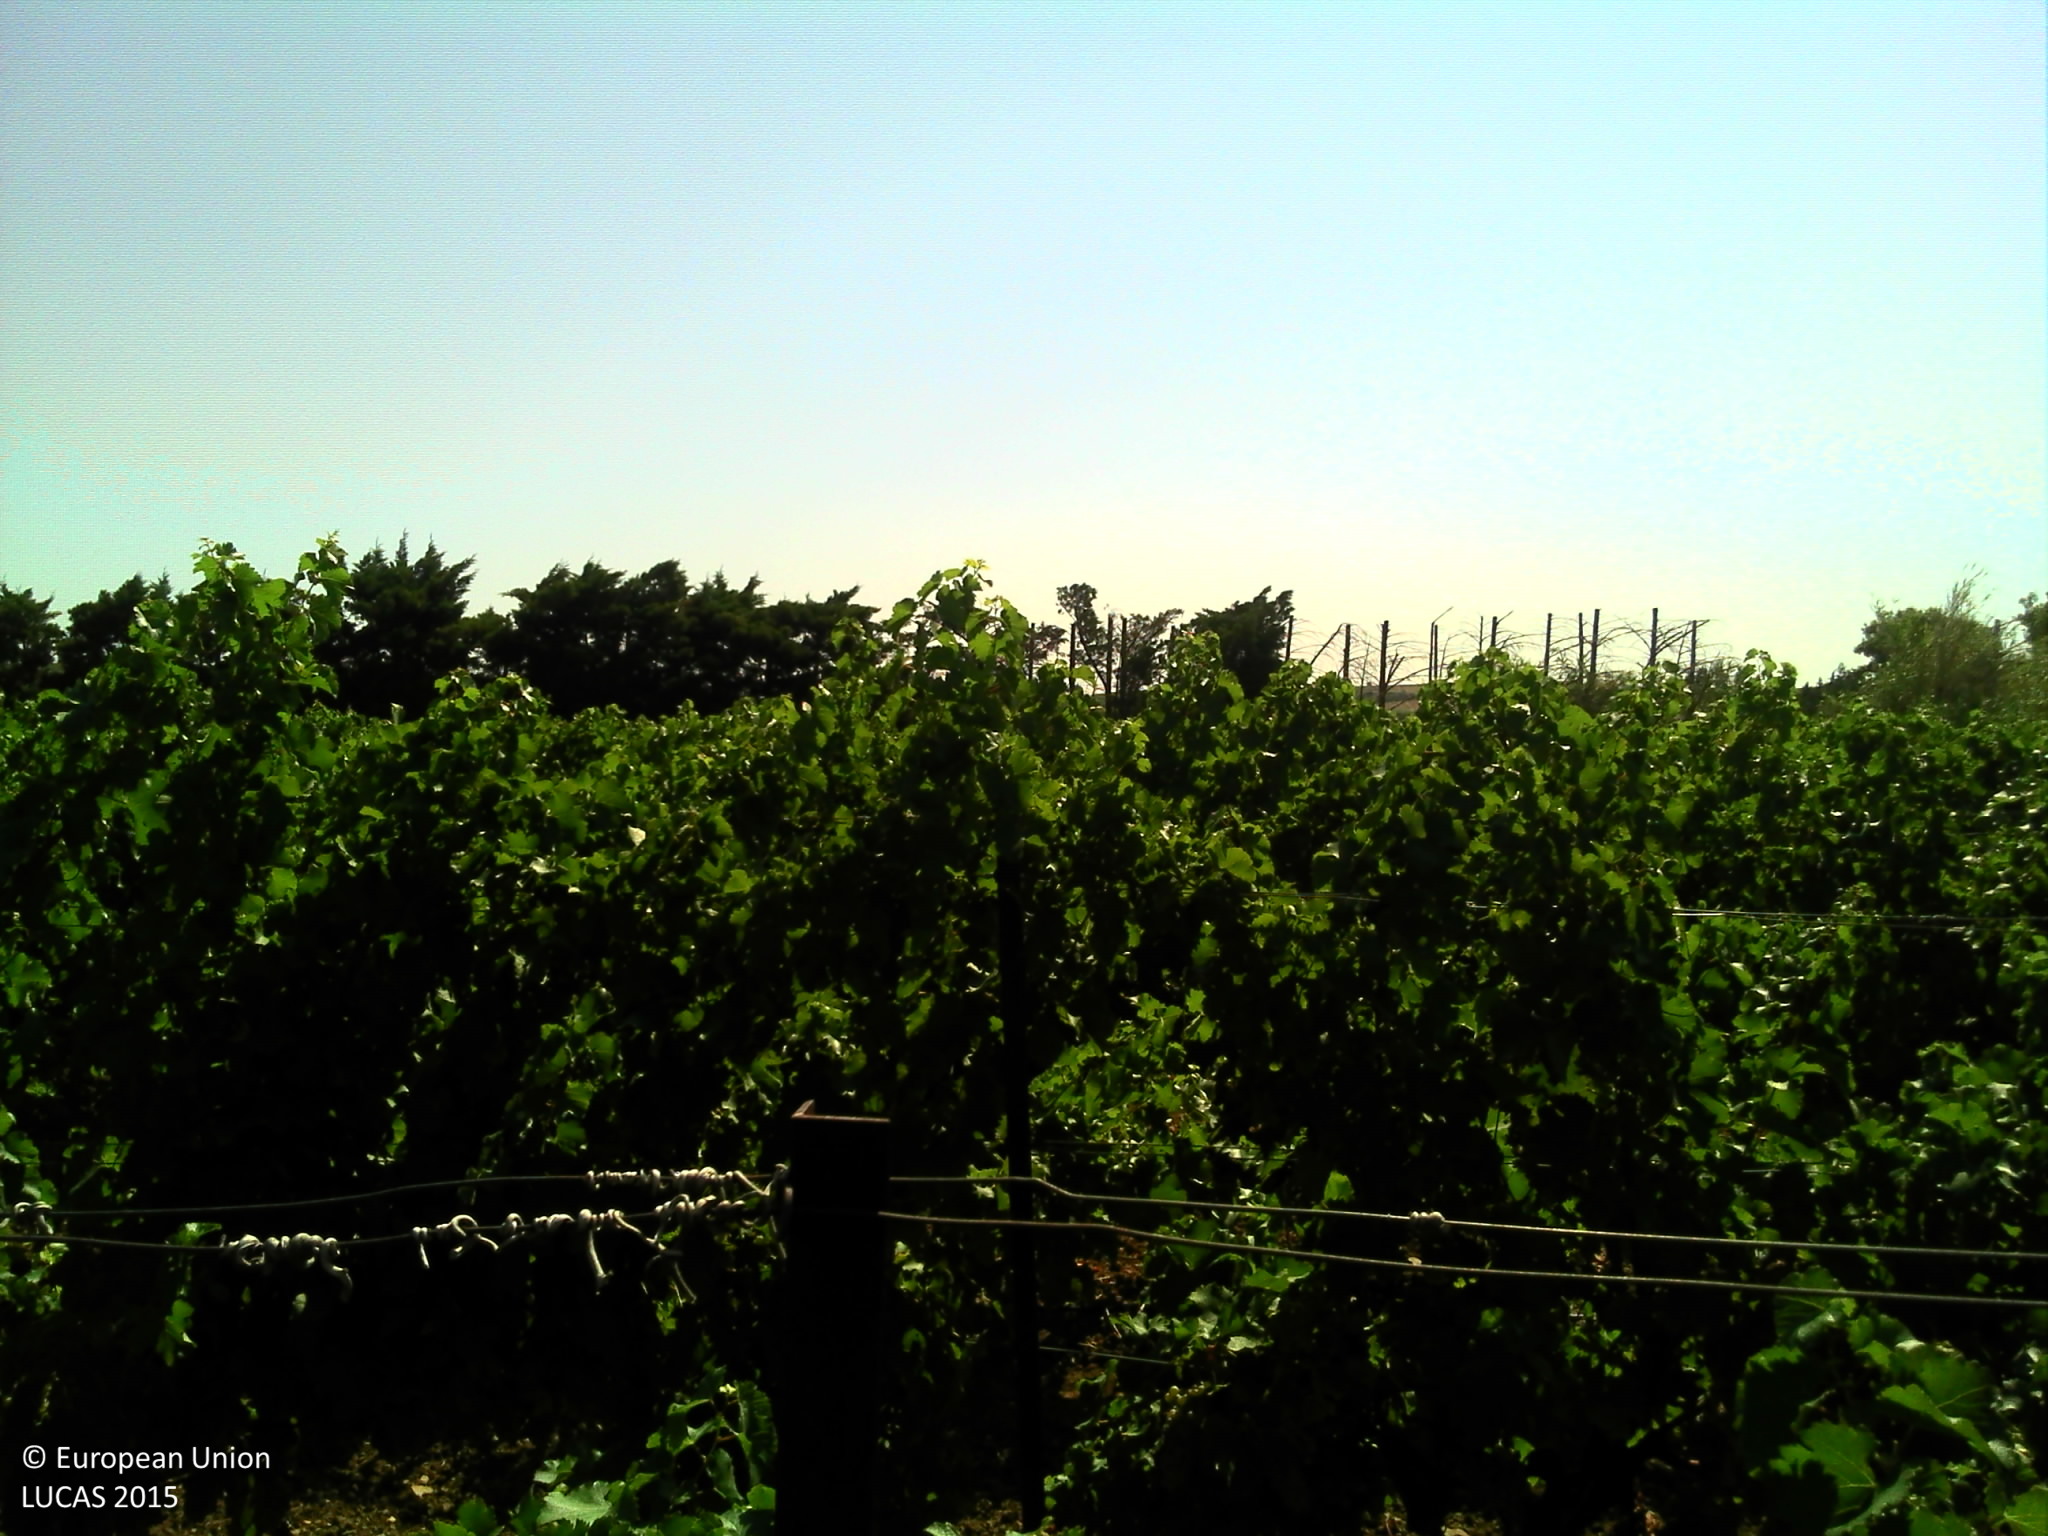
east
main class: Cropland
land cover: Vineyards
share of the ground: 10 - 25 %
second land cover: Other bare soil
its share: > 75 %
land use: Agriculture (excluding fallow land and kitchen gardens)
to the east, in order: Vineyards; Other bare soil; Grass margins; Paved roads, cycling and walking lanes; Grass margins; Conifer hedges; Grassland without tree/shrub cover; Fences; Grassland without tree/shrub cover; Conifer hedges; Vineyards; Grassland without tree/shrub cover; Vineyards
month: August
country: FR
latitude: 43.5620
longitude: 3.4102
